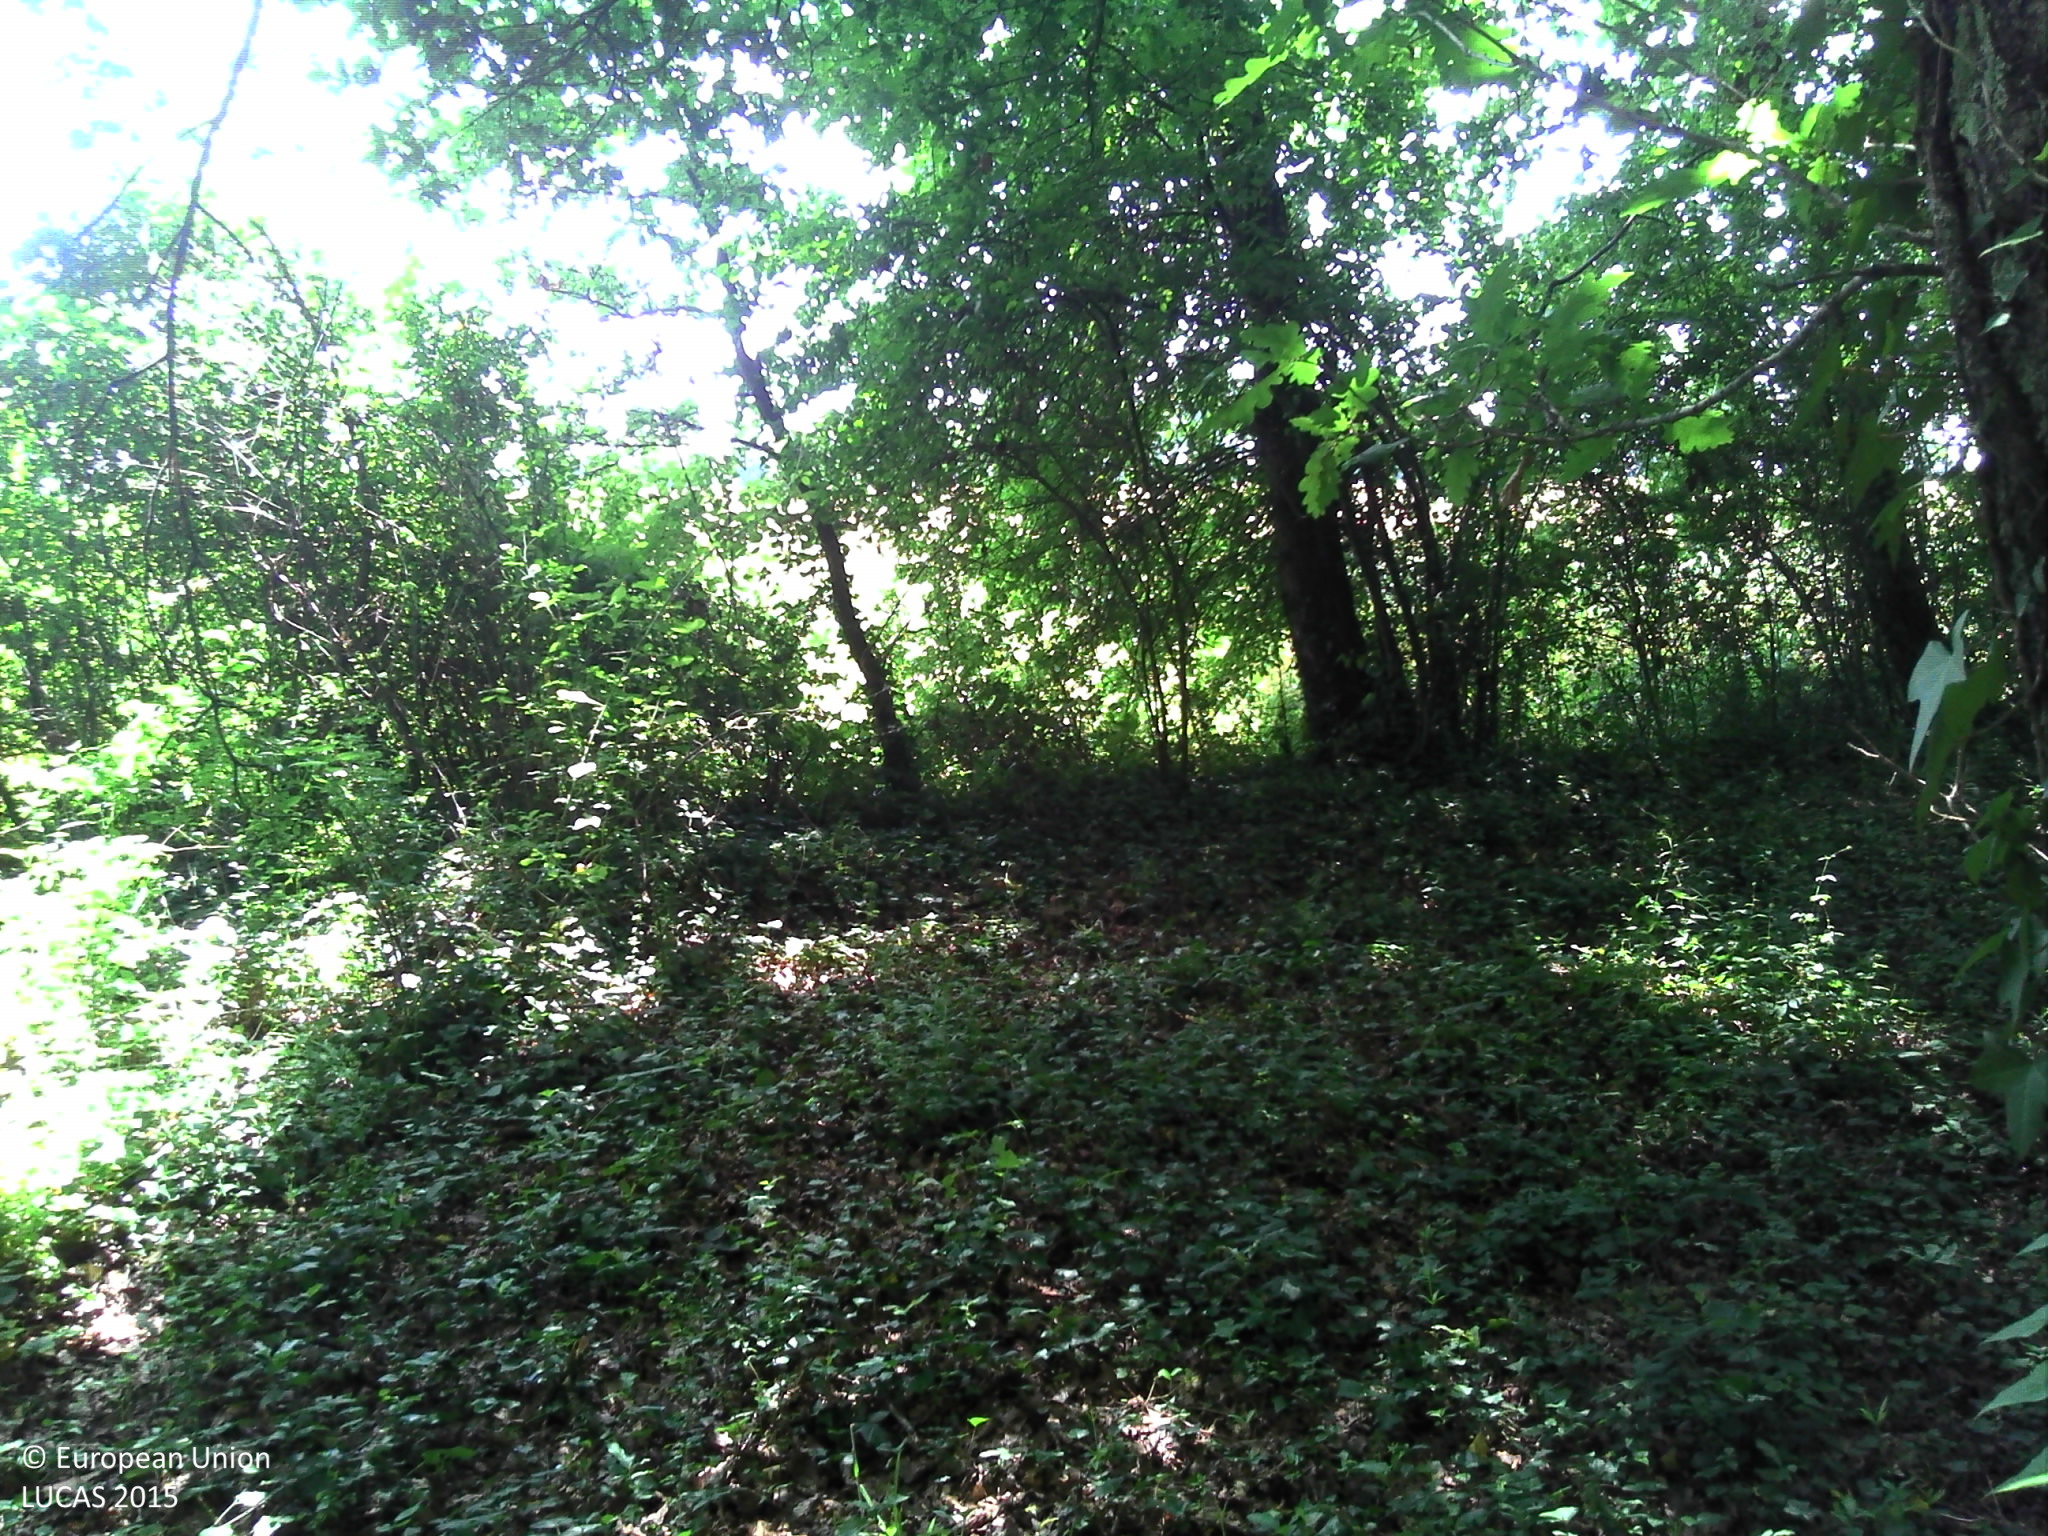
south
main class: Woodland
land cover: Broadleaved woodland
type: mesophytic deciduous forest
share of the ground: > 75 %
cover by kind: broadleaved forest trees 95 %, herbaceous plants 5 %
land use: Forestry
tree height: > 5 m
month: June
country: FR
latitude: 46.5395
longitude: 0.4500
